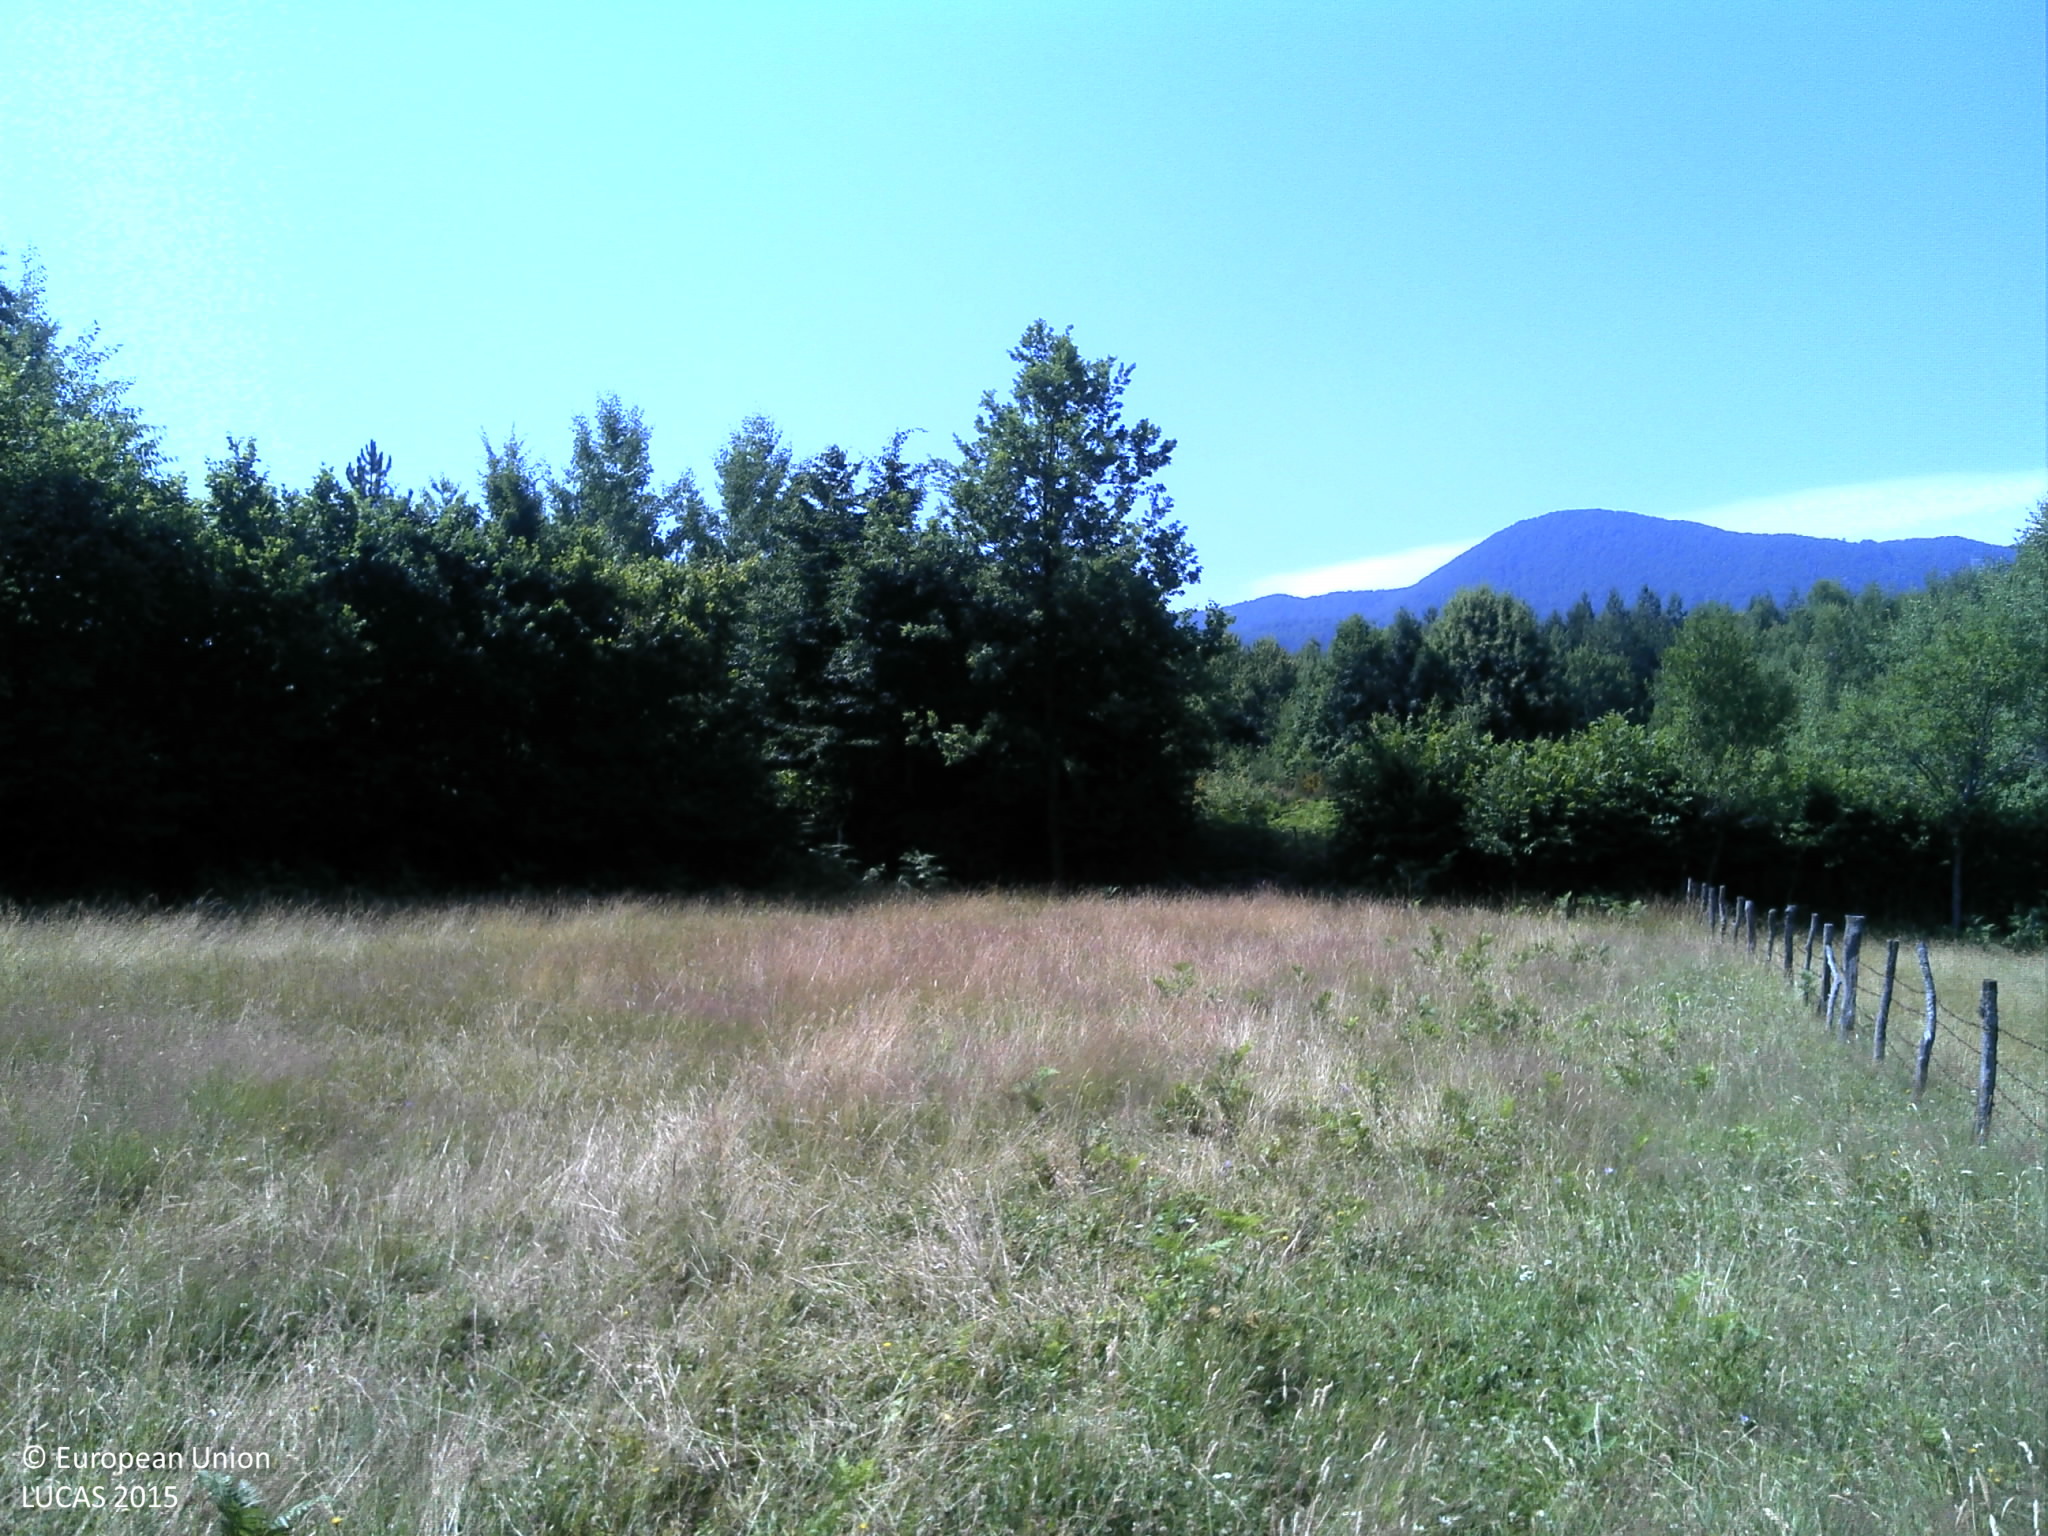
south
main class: Cropland
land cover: Other fruit trees and berries
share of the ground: 25 - 50 %
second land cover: Grassland without tree/shrub cover
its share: > 75 %
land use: Agriculture (excluding fallow land and kitchen gardens)
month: July
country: HR
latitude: 44.6370
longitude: 15.1748
